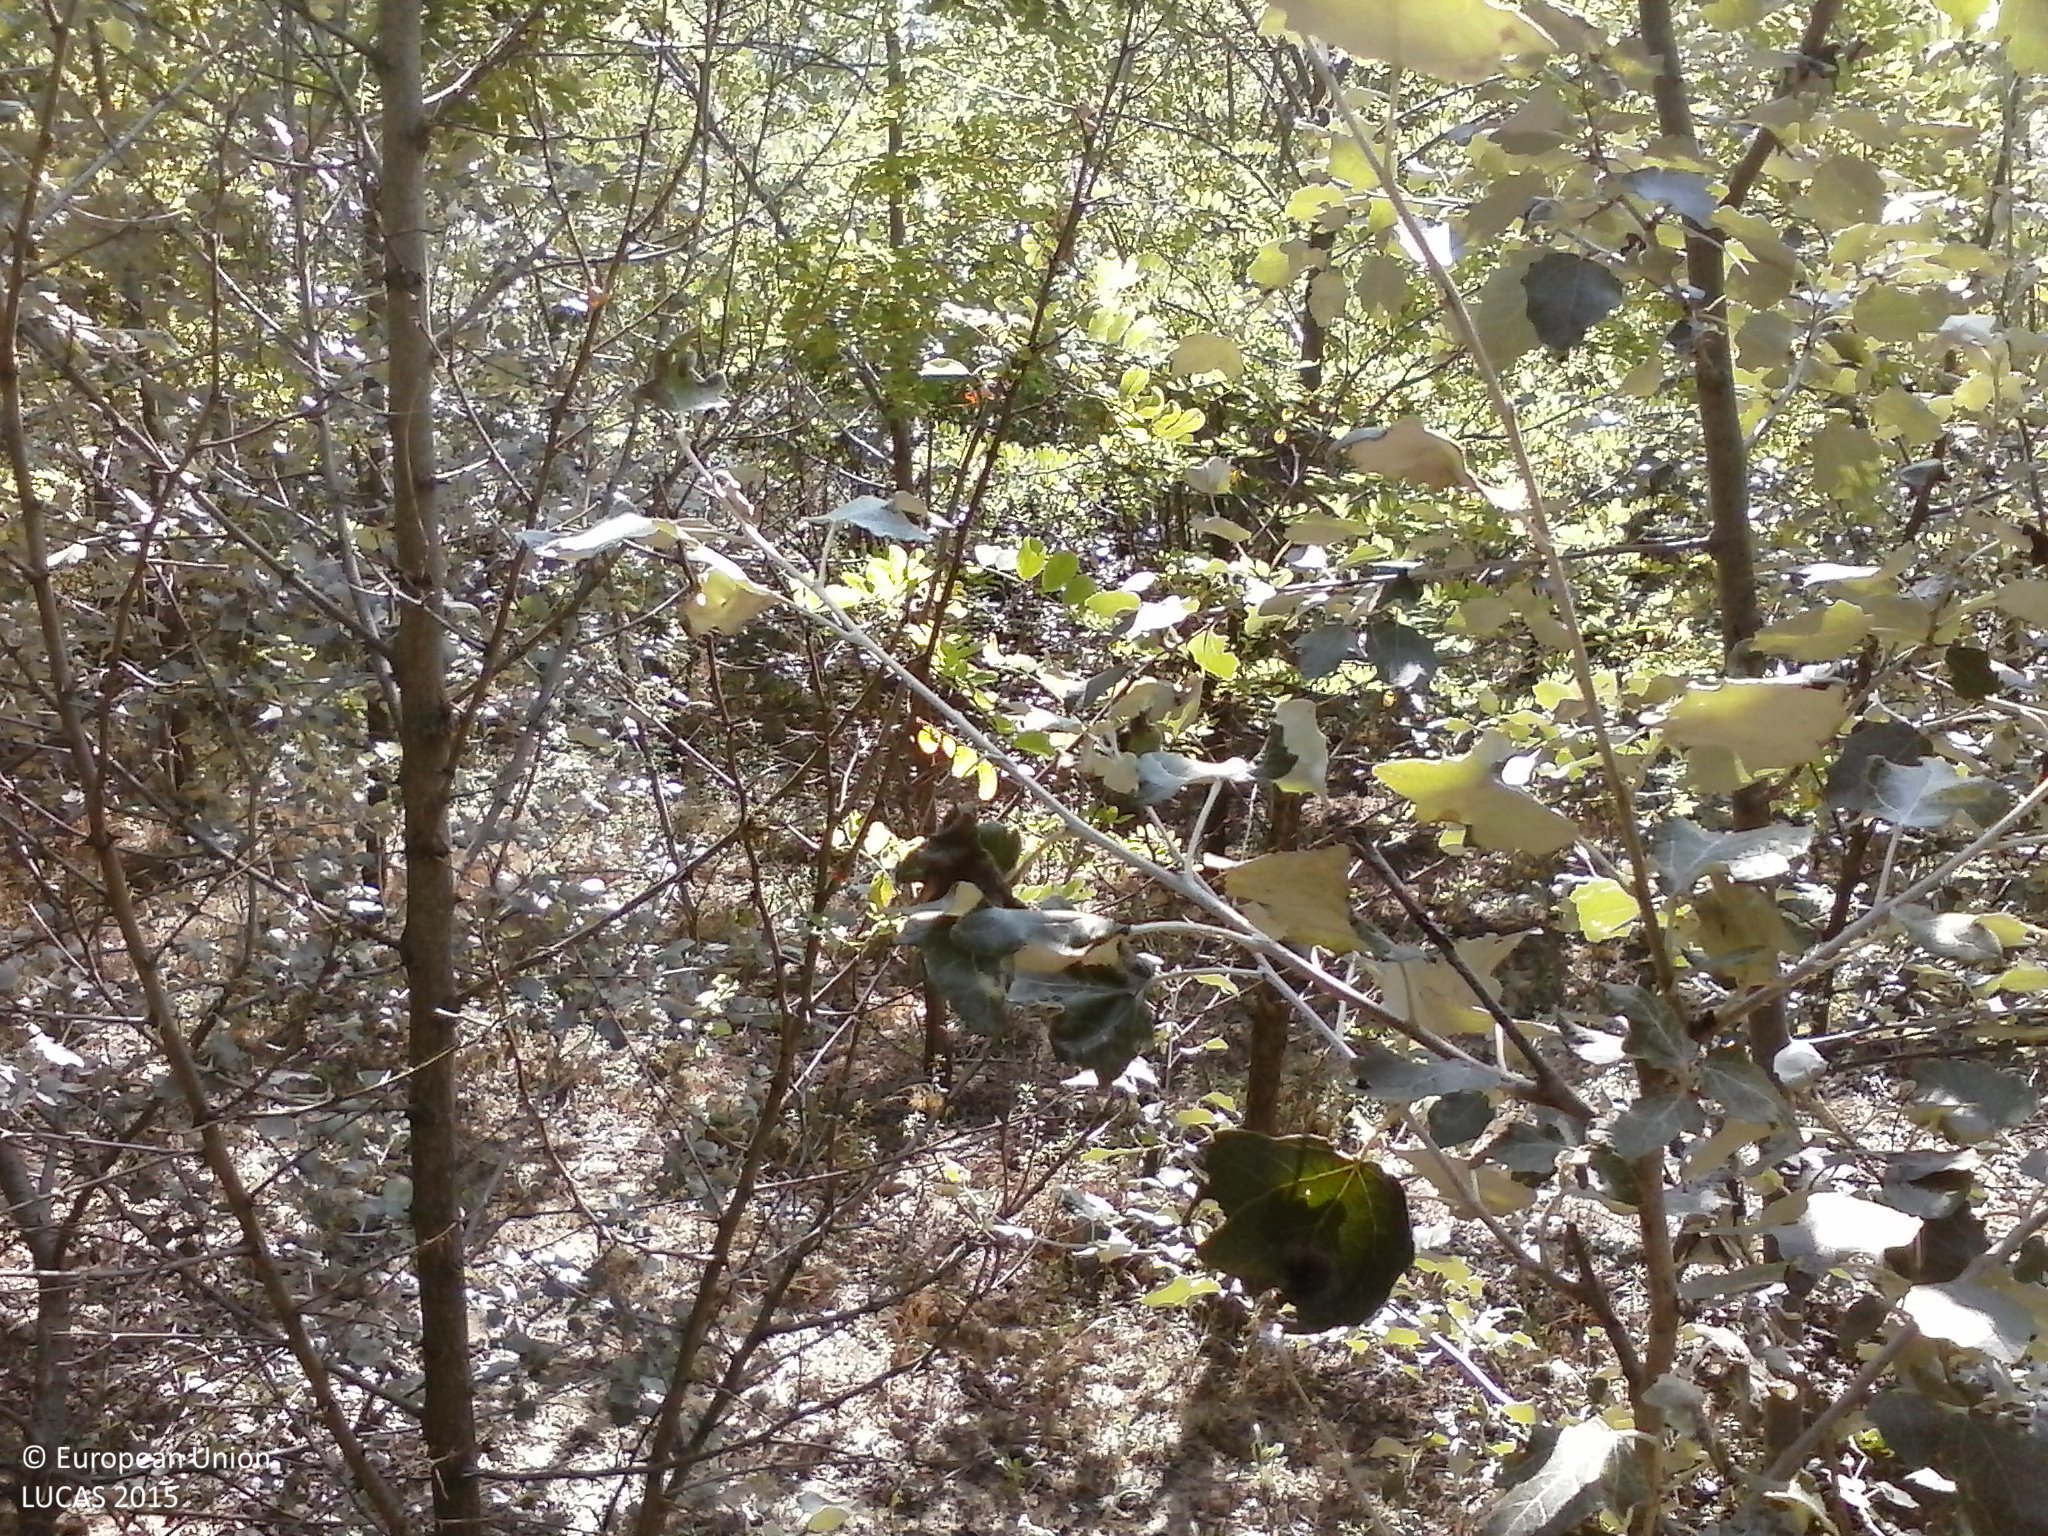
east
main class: Woodland
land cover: Broadleaved woodland
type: exotic forest
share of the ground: > 75 %
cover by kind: broadleaved forest trees 95 %, consolidated bare surface 5 %
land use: Forestry
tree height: < 5 m
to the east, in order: Broadleaved woodland; Pine dominated coniferous woodland; Tracks; Pine dominated coniferous woodland
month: July
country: HU
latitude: 46.2758
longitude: 19.6597
